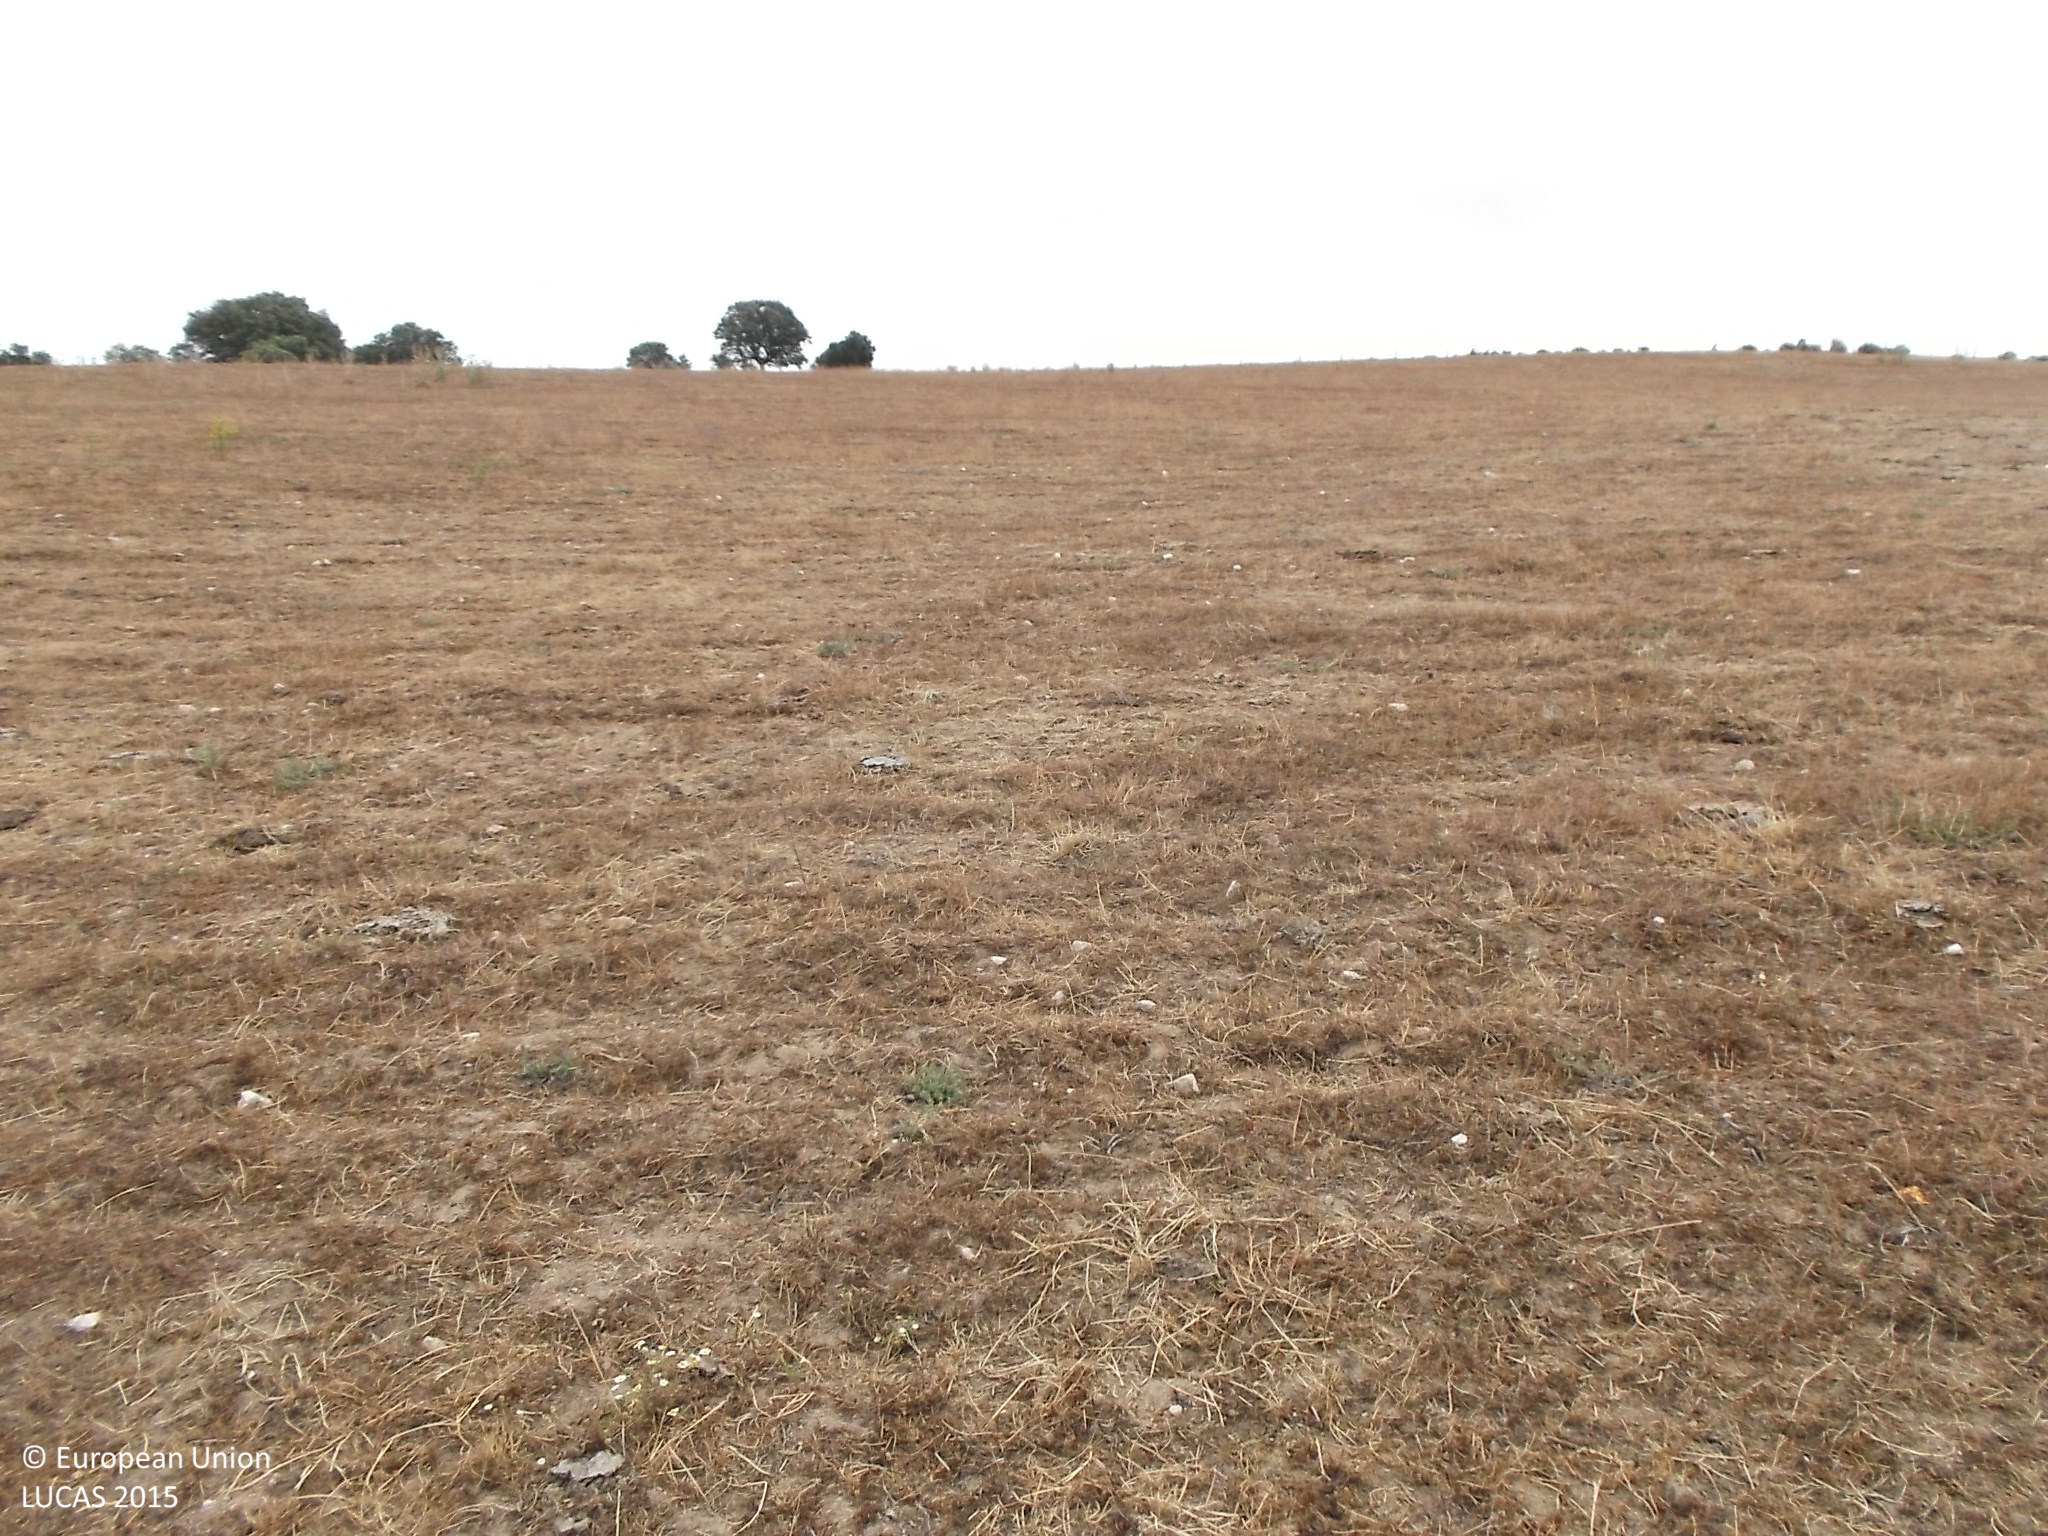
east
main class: Grassland
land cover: Grassland without tree/shrub cover
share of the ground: > 75 %
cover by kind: herbaceous plants 100 %
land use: Agriculture (excluding fallow land and kitchen gardens)
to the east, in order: Grassland without tree/shrub cover; Fences; Grassland without tree/shrub cover; Fences; Grass margins; Tracks; Grass margins; Fences; Grass margins; Temporary grasslands
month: July
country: ES
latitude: 41.0834
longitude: -6.4143
